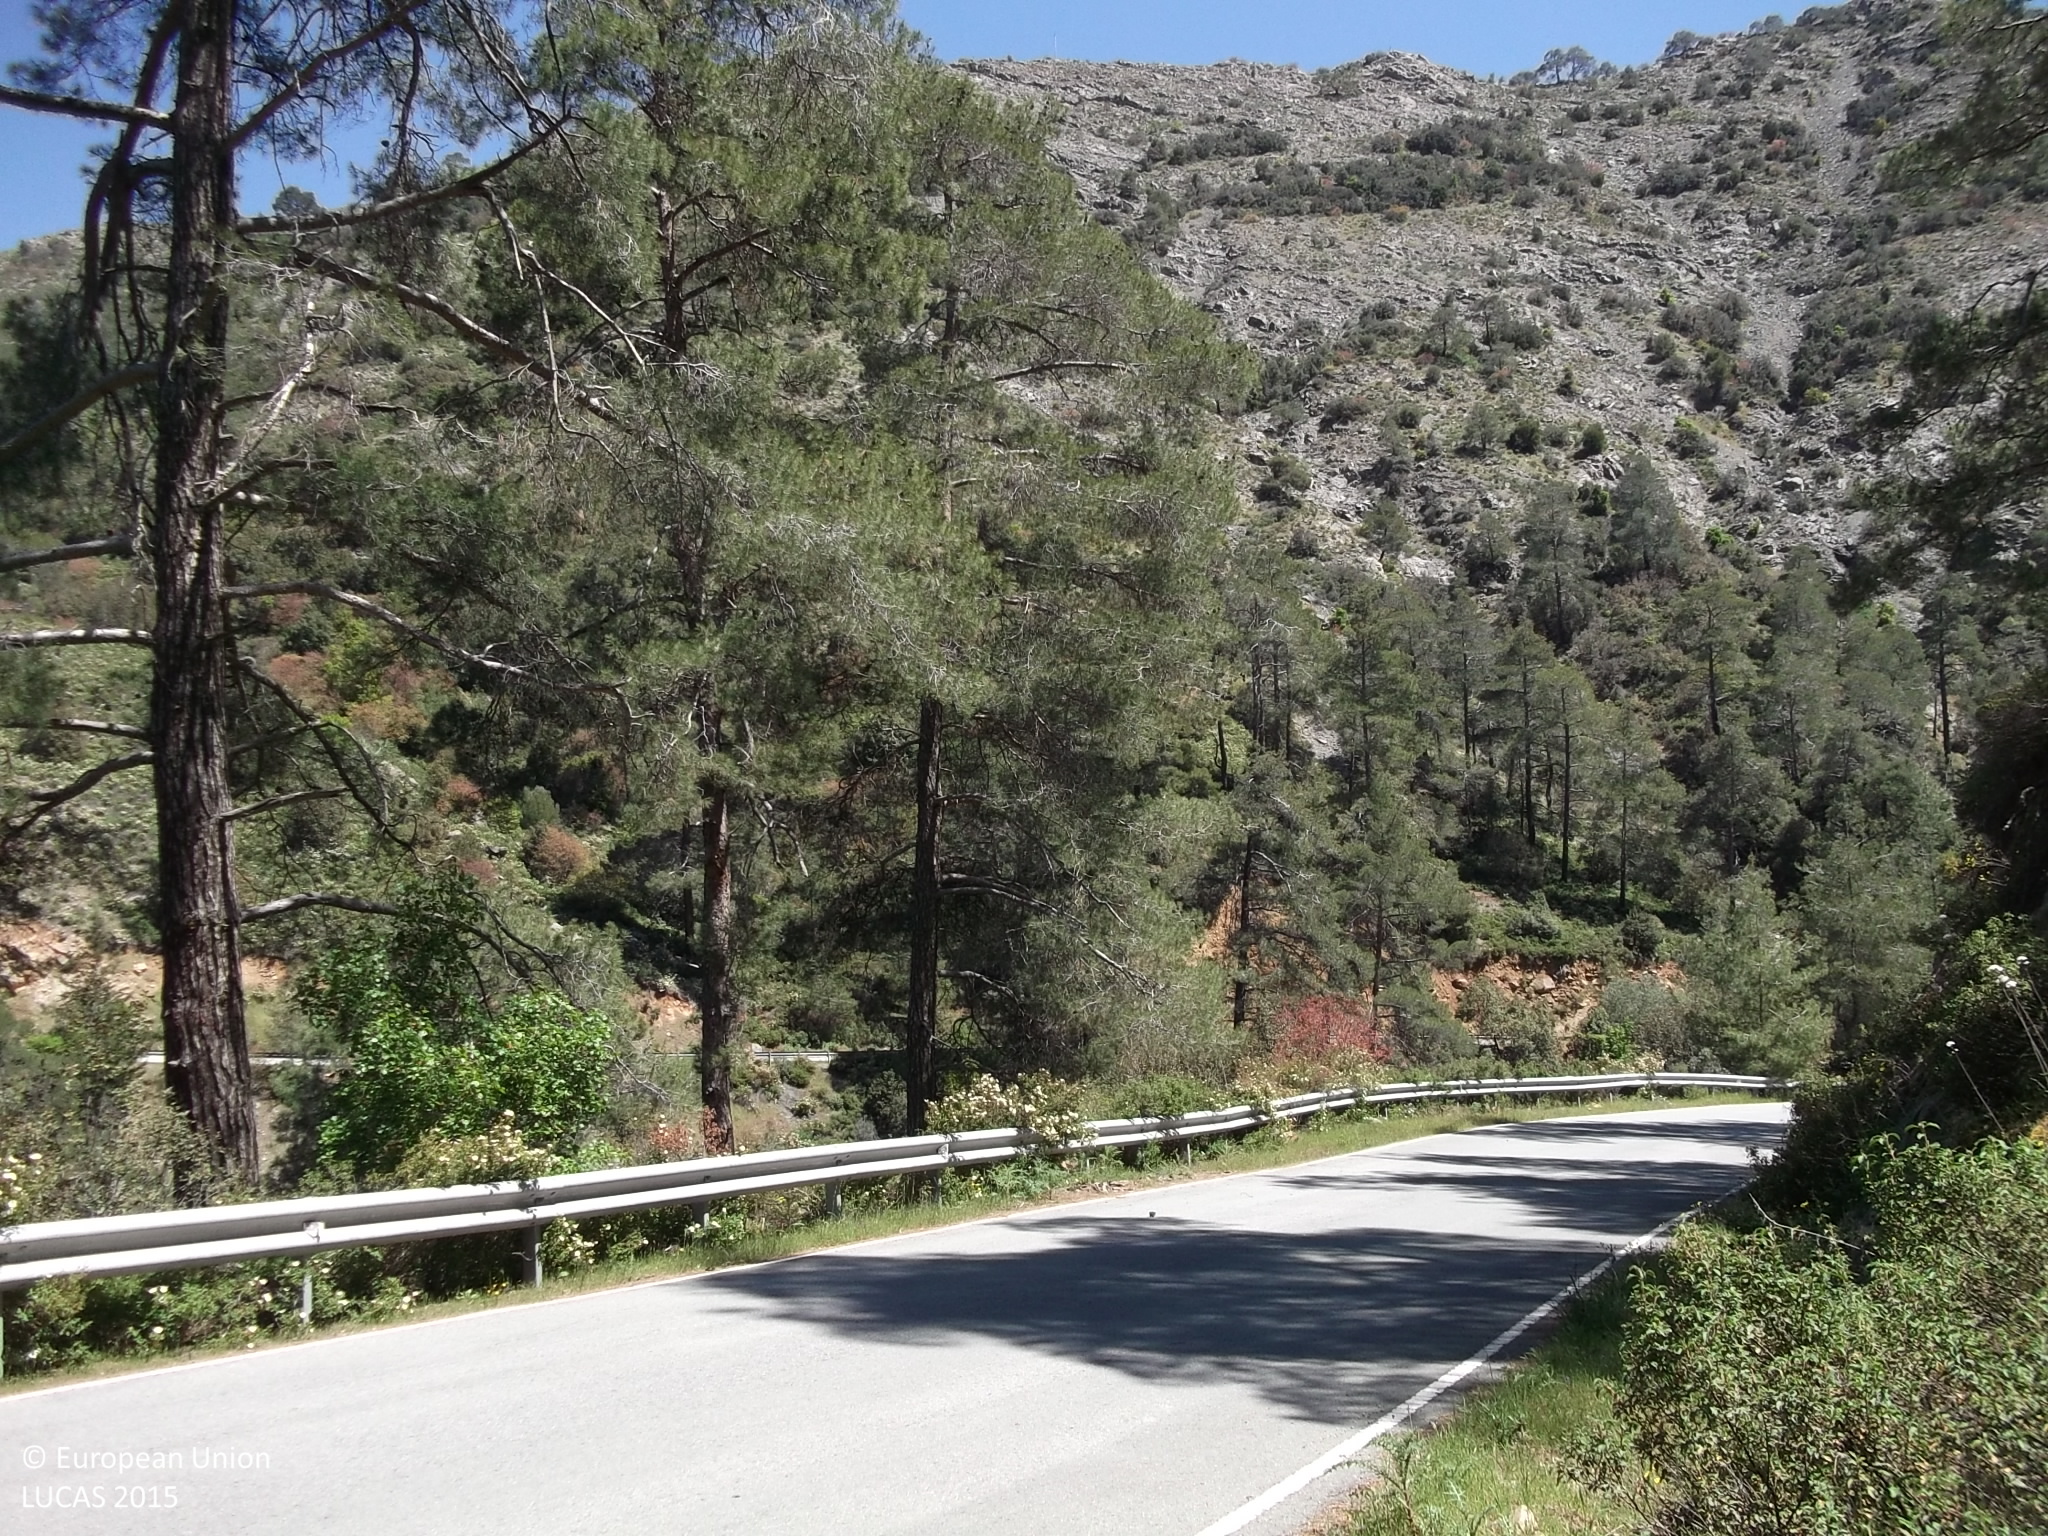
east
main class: Shrubland
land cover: Shrubland with sparse tree cover
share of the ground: > 75 %
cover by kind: shrubs 90 %, coniferous forest trees 5 %, unconsolidated bare surface 5 %
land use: Semi-natural and natural areas not in use
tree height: > 5 m
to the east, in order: Shrubland with sparse tree cover; Pine dominated coniferous woodland
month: April
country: CY
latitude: 34.9351
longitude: 33.1808
